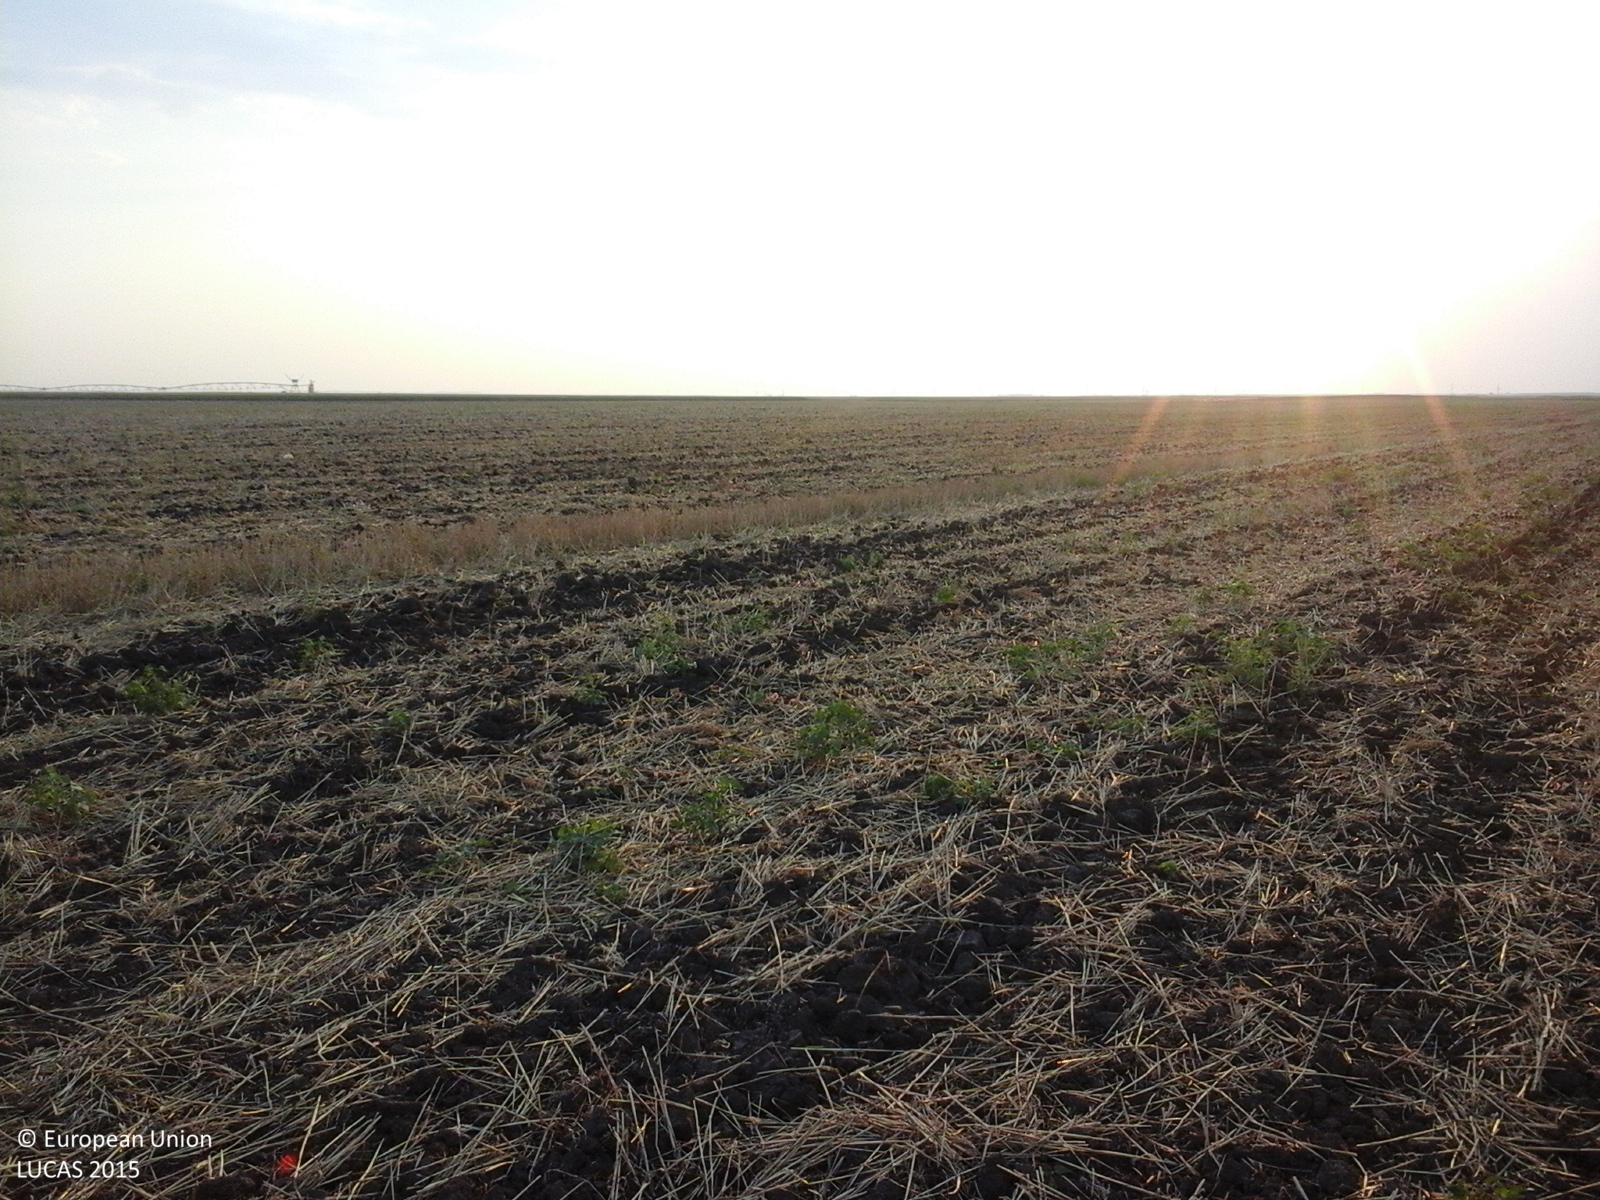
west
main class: Cropland
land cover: Common wheat
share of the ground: 50 - 75 %
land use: Agriculture (excluding fallow land and kitchen gardens)
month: August
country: RO
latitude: 44.0137
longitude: 23.2044
